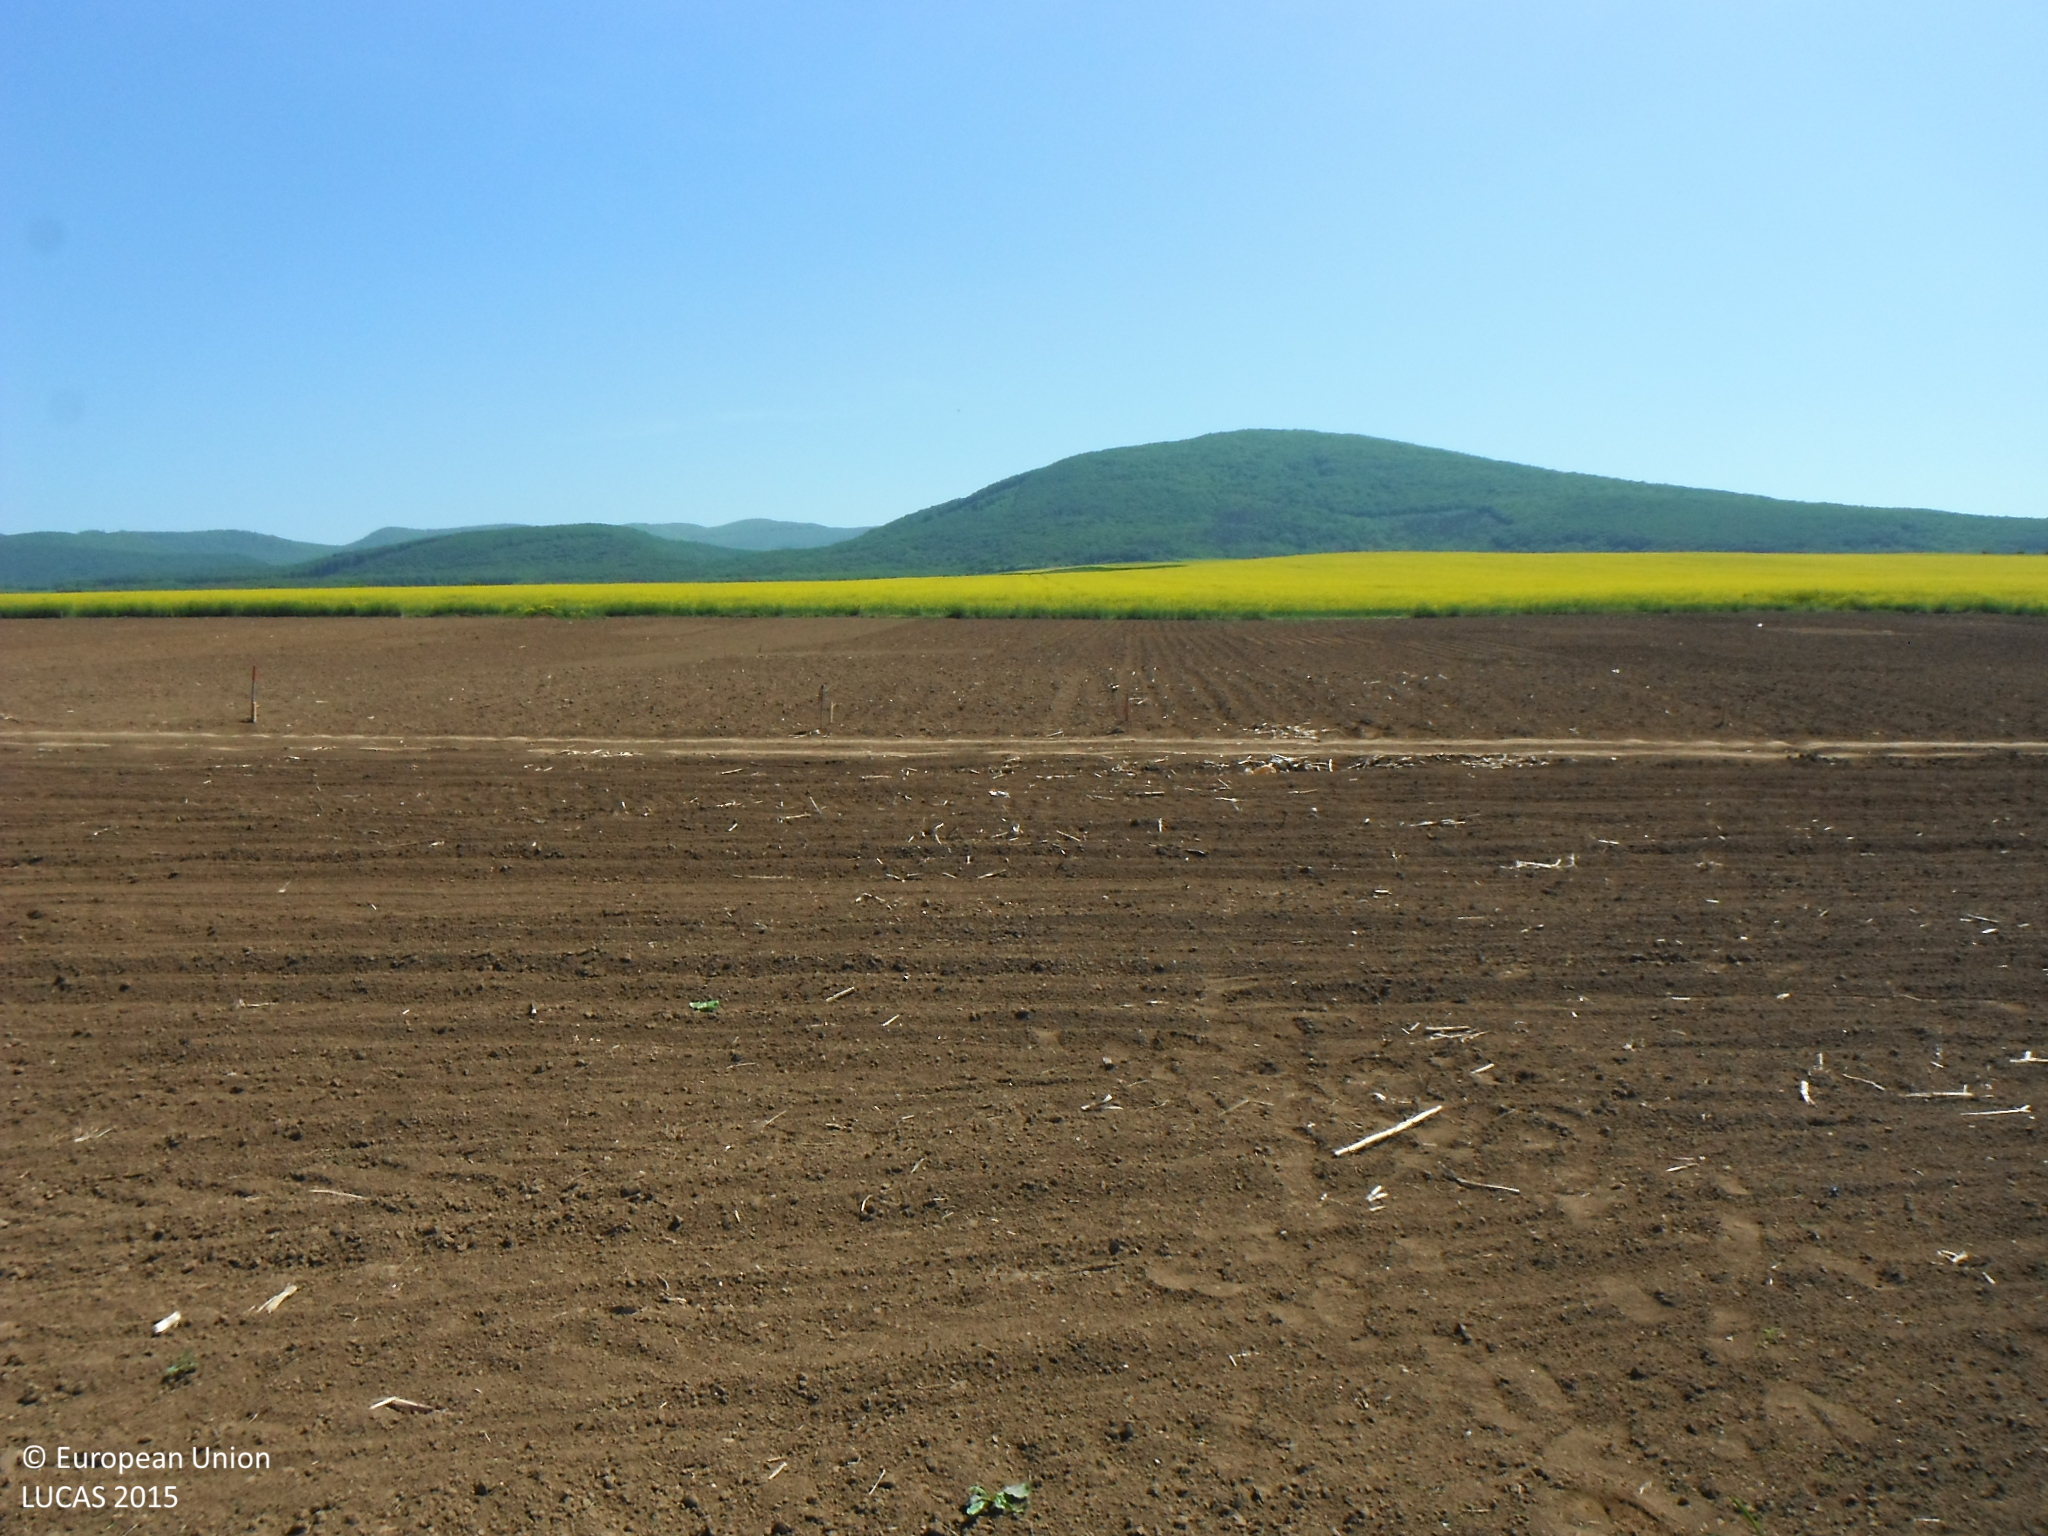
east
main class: Cropland
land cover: Maize
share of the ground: < 10 %
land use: Agriculture (excluding fallow land and kitchen gardens)
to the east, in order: Grass margins; Maize; Tracks; Other bare soil; Rape and turnip rape
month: May
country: SK
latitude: 48.5636
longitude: 21.3328
